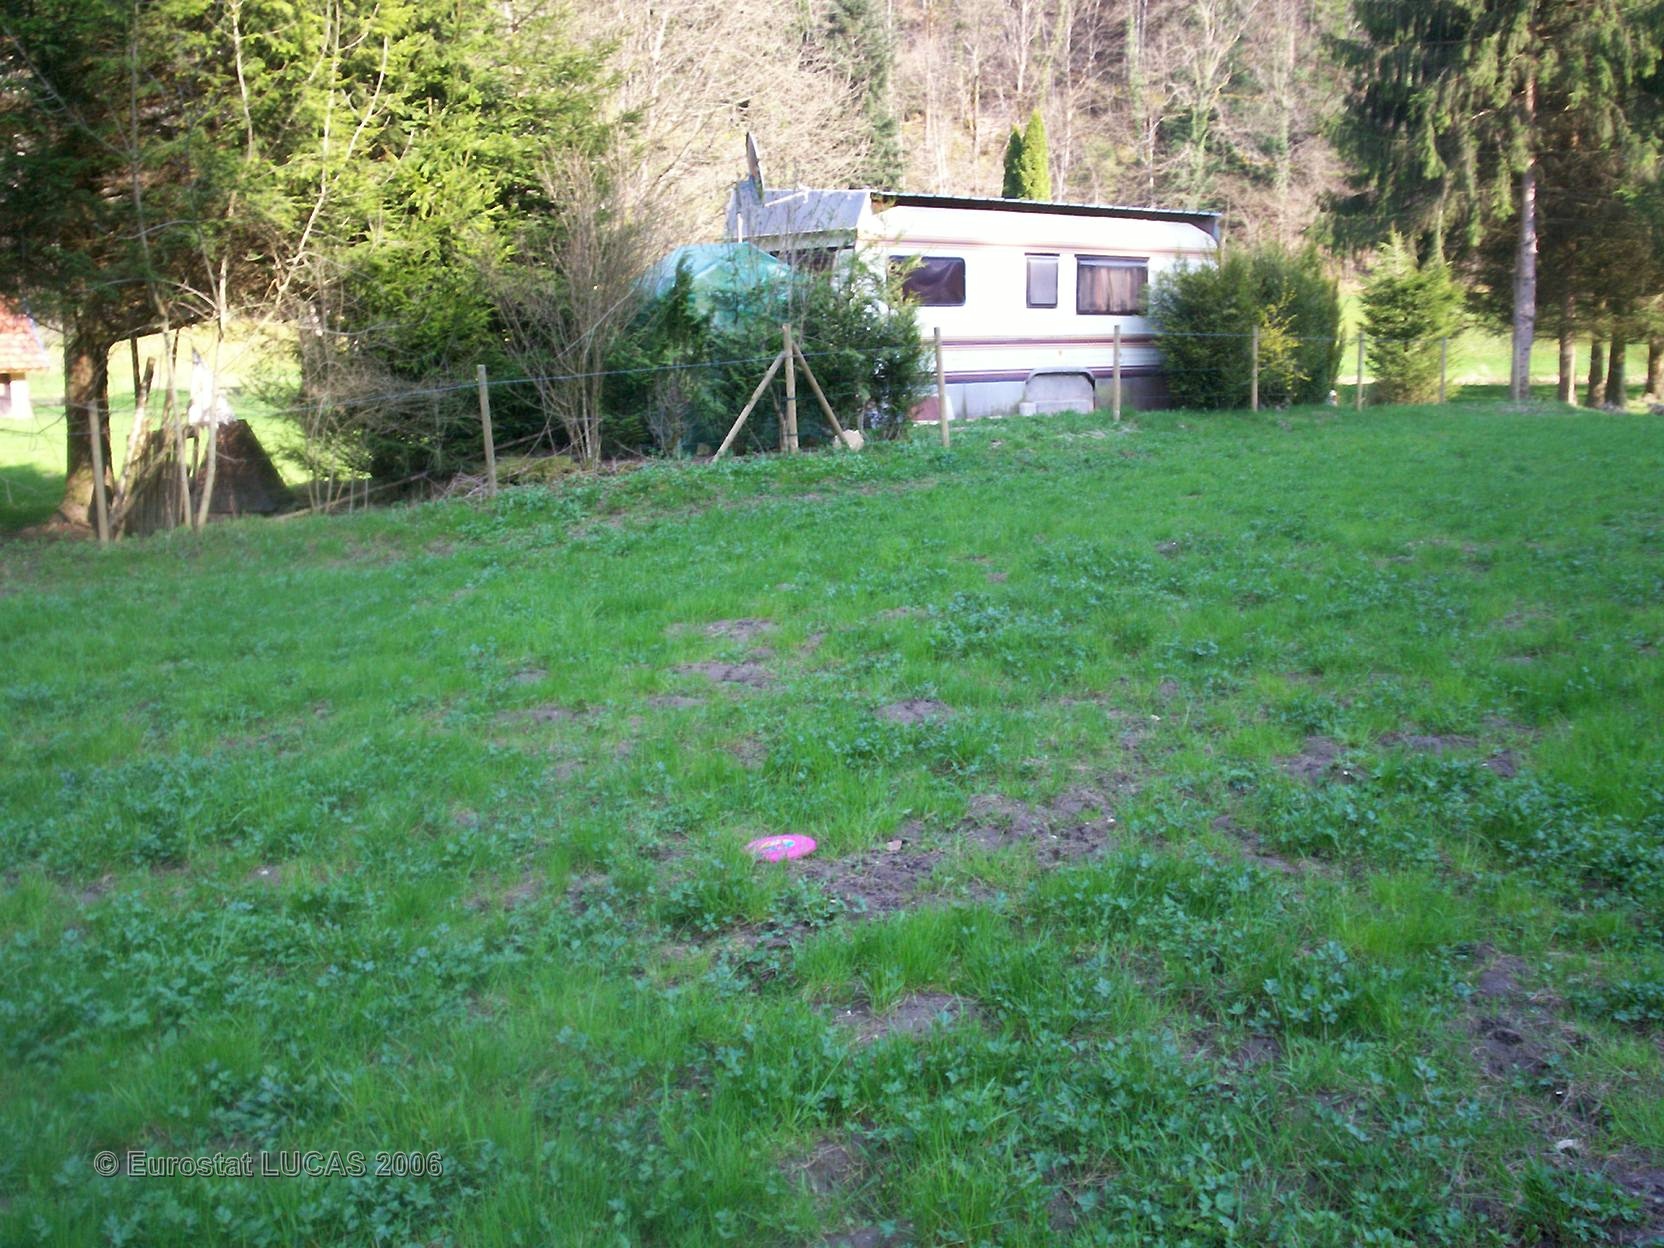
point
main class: Grassland
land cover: Grassland without tree/shrub cover
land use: Residential
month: April
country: FR
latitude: 47.3002
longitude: 6.9998
